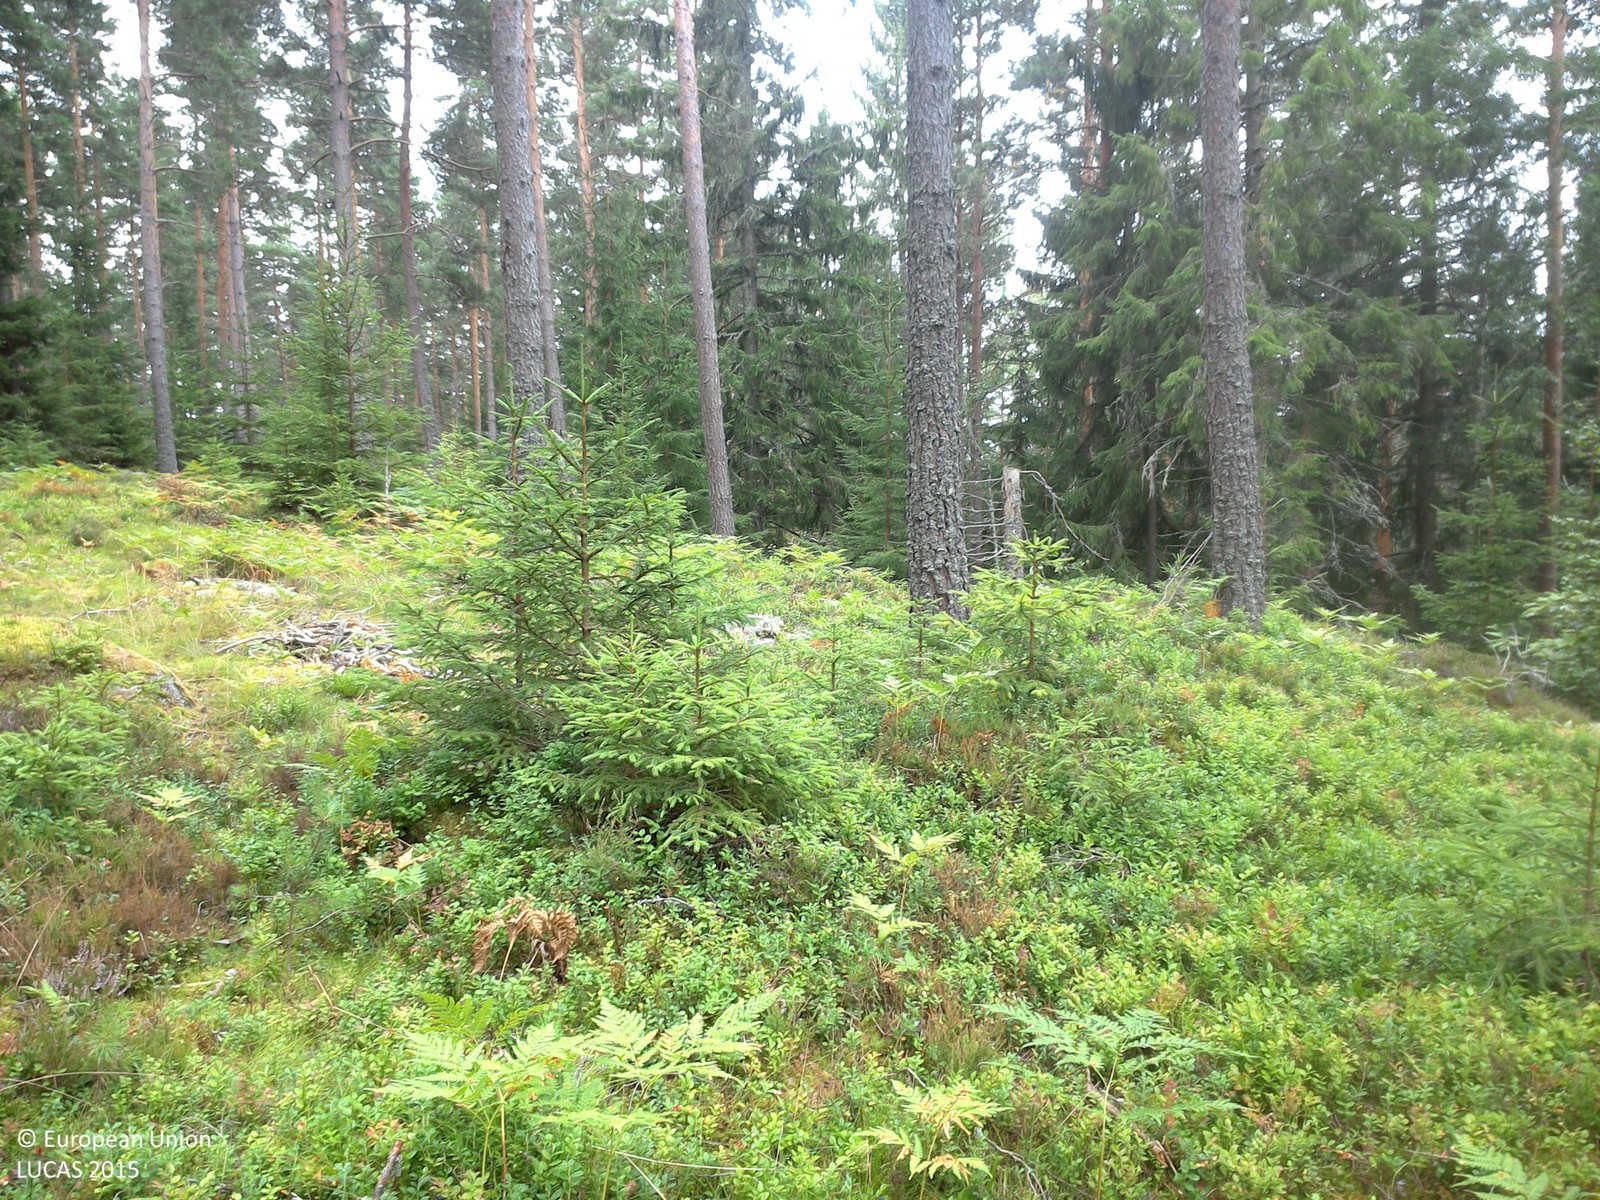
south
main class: Woodland
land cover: Pine dominated coniferous woodland
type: boreal forest
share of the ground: 10 - 25 %
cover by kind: shrubs 50 %, coniferous forest trees 20 %, herbaceous plants 20 %, lichens and mosses 10 %
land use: Forestry
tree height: > 5 m
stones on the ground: < 10 %
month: August
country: SE
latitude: 57.8419
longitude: 15.3693
